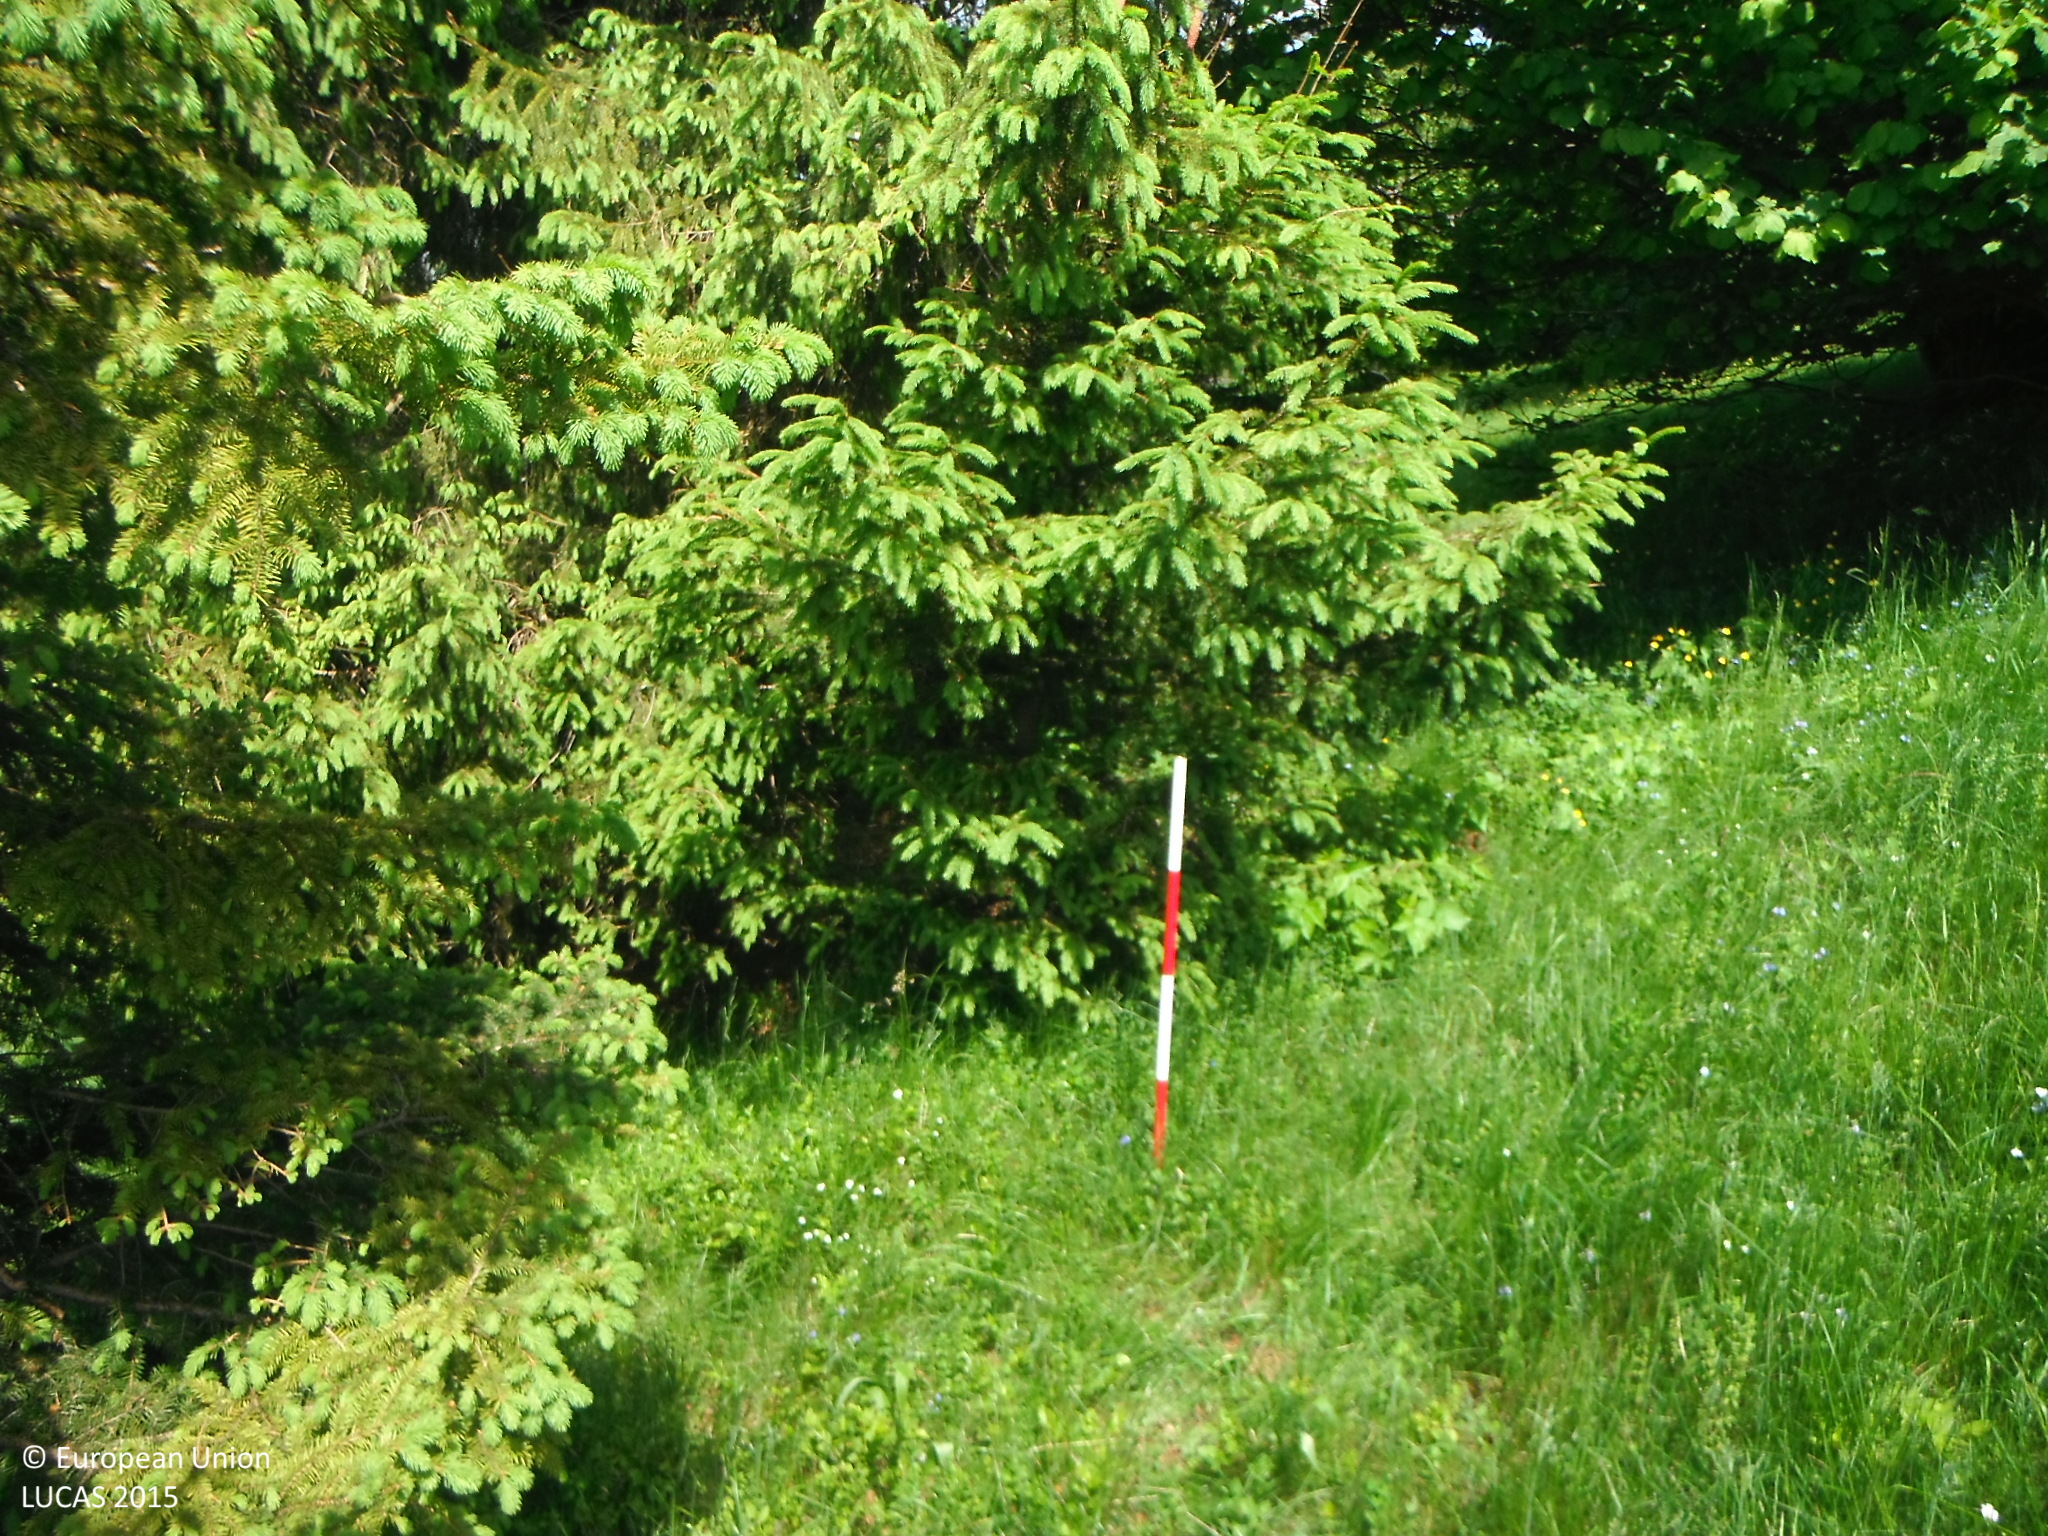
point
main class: Woodland
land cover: Spruce dominated mixed woodland
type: hemiboreal forest and nemoral coniferous forest and mixed broadleaved-coniferous forest
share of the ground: 25 - 50 %
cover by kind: herbaceous plants 60 %, coniferous forest trees 20 %, broadleaved forest trees 20 %
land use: Agriculture (excluding fallow land and kitchen gardens)
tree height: > 5 m
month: June
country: SK
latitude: 49.2887
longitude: 20.4159
